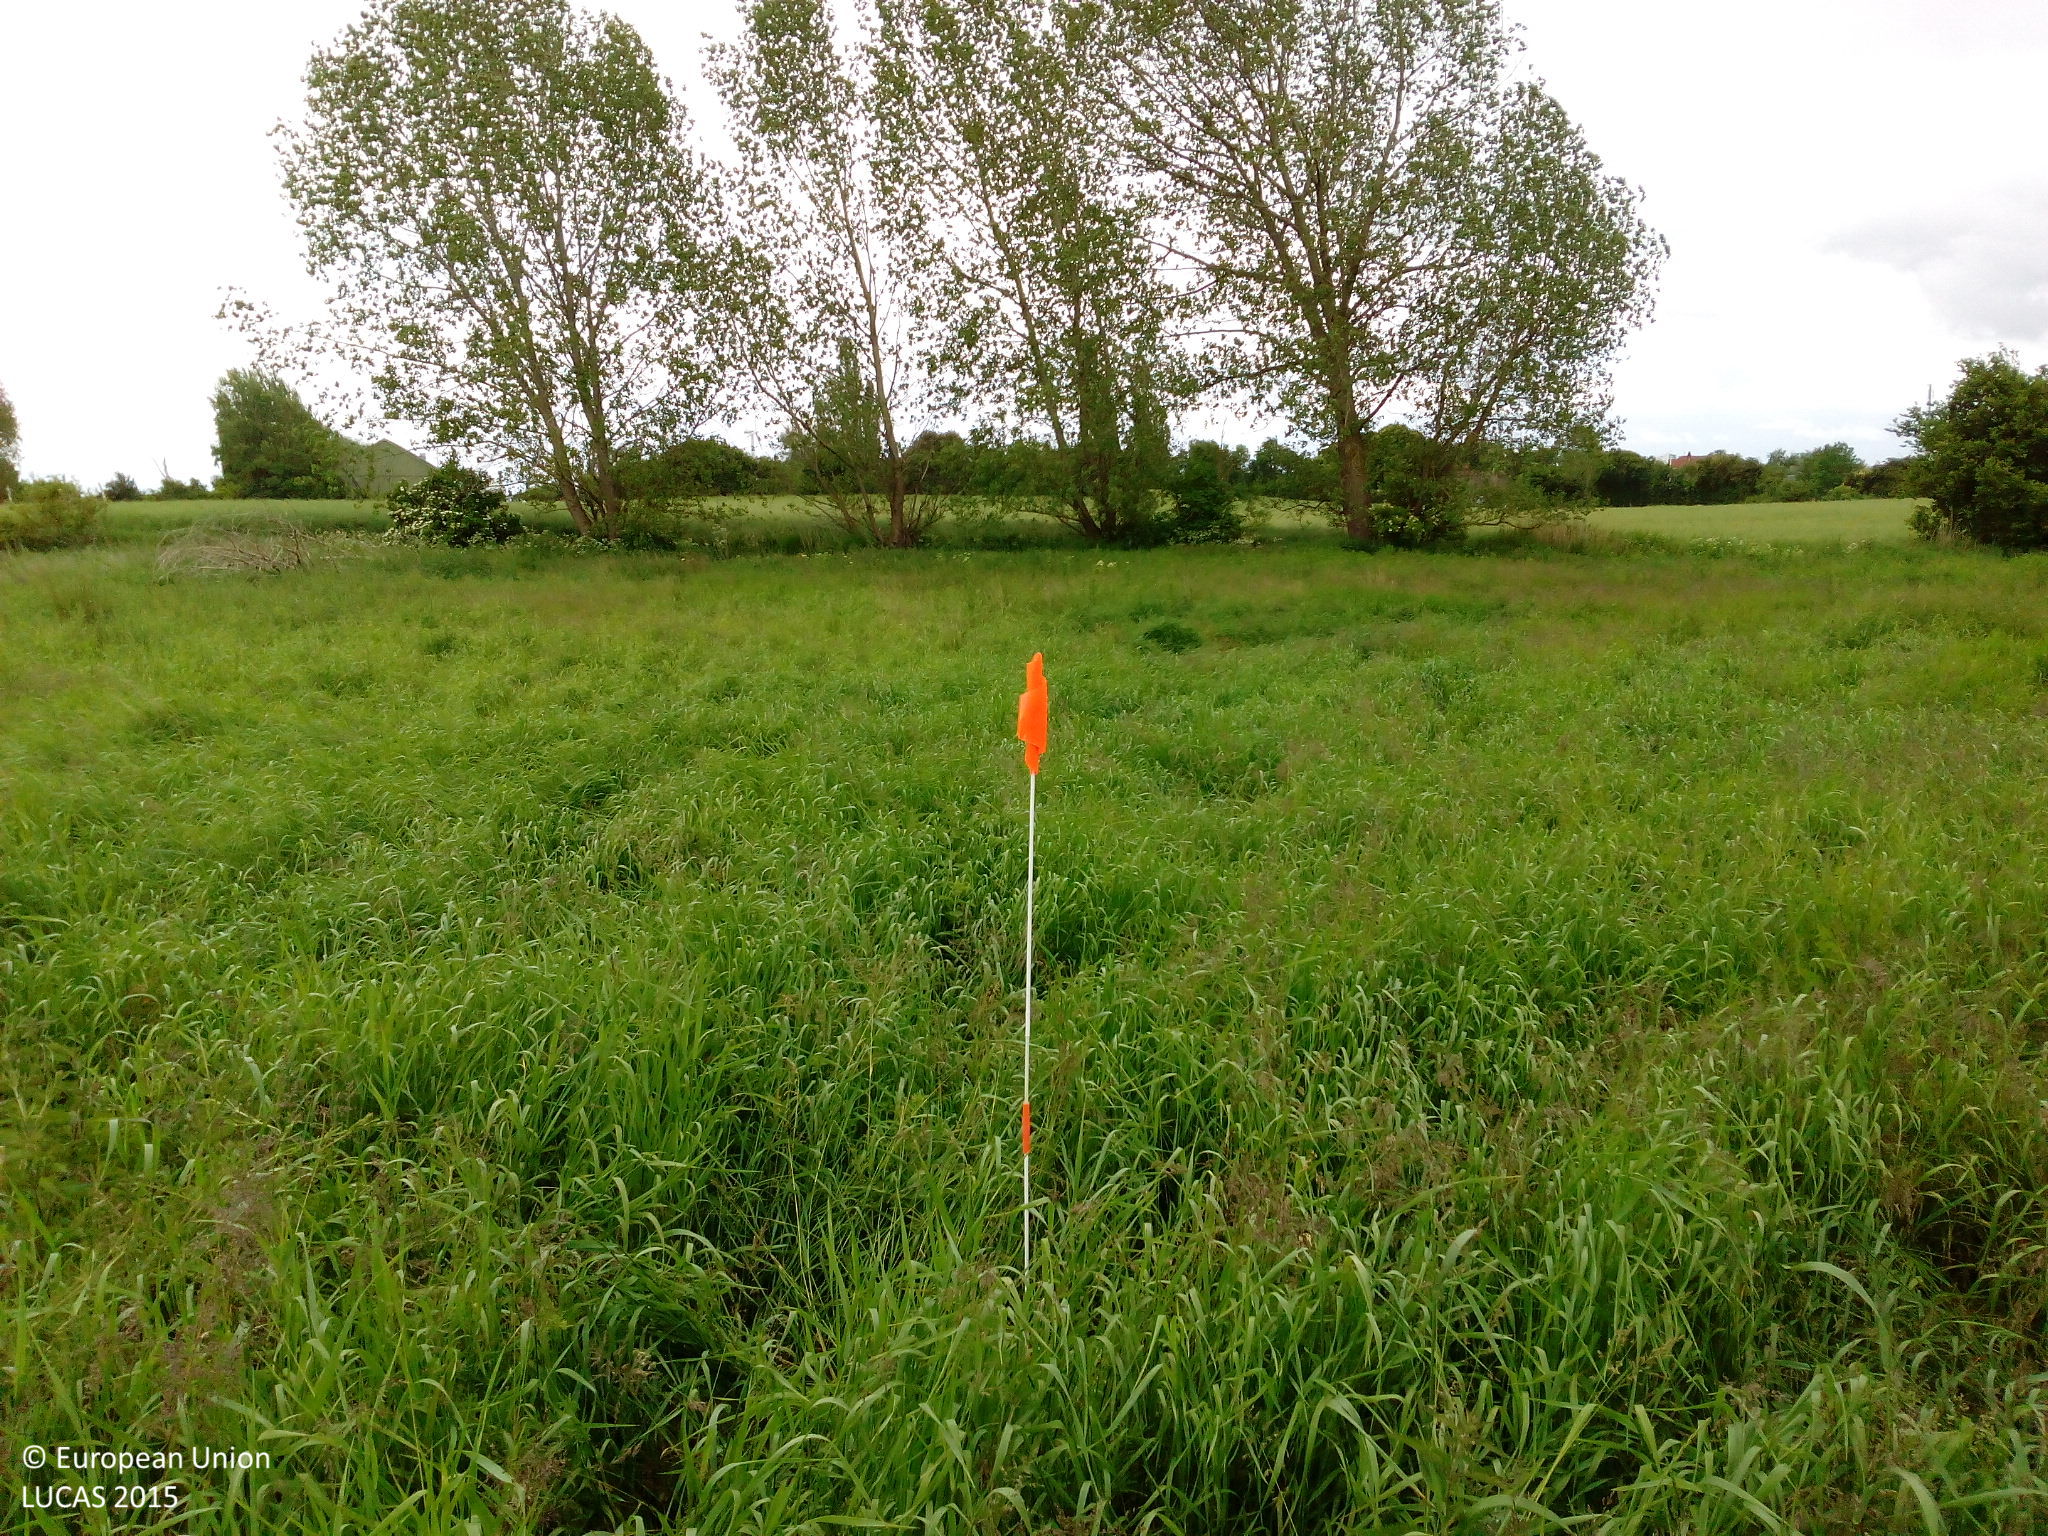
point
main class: Grassland
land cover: Spontaneously vegetated surfaces
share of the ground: > 75 %
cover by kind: herbaceous plants 100 %
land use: Semi-natural and natural areas not in use
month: June
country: DK
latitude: 54.9454
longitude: 10.7332
